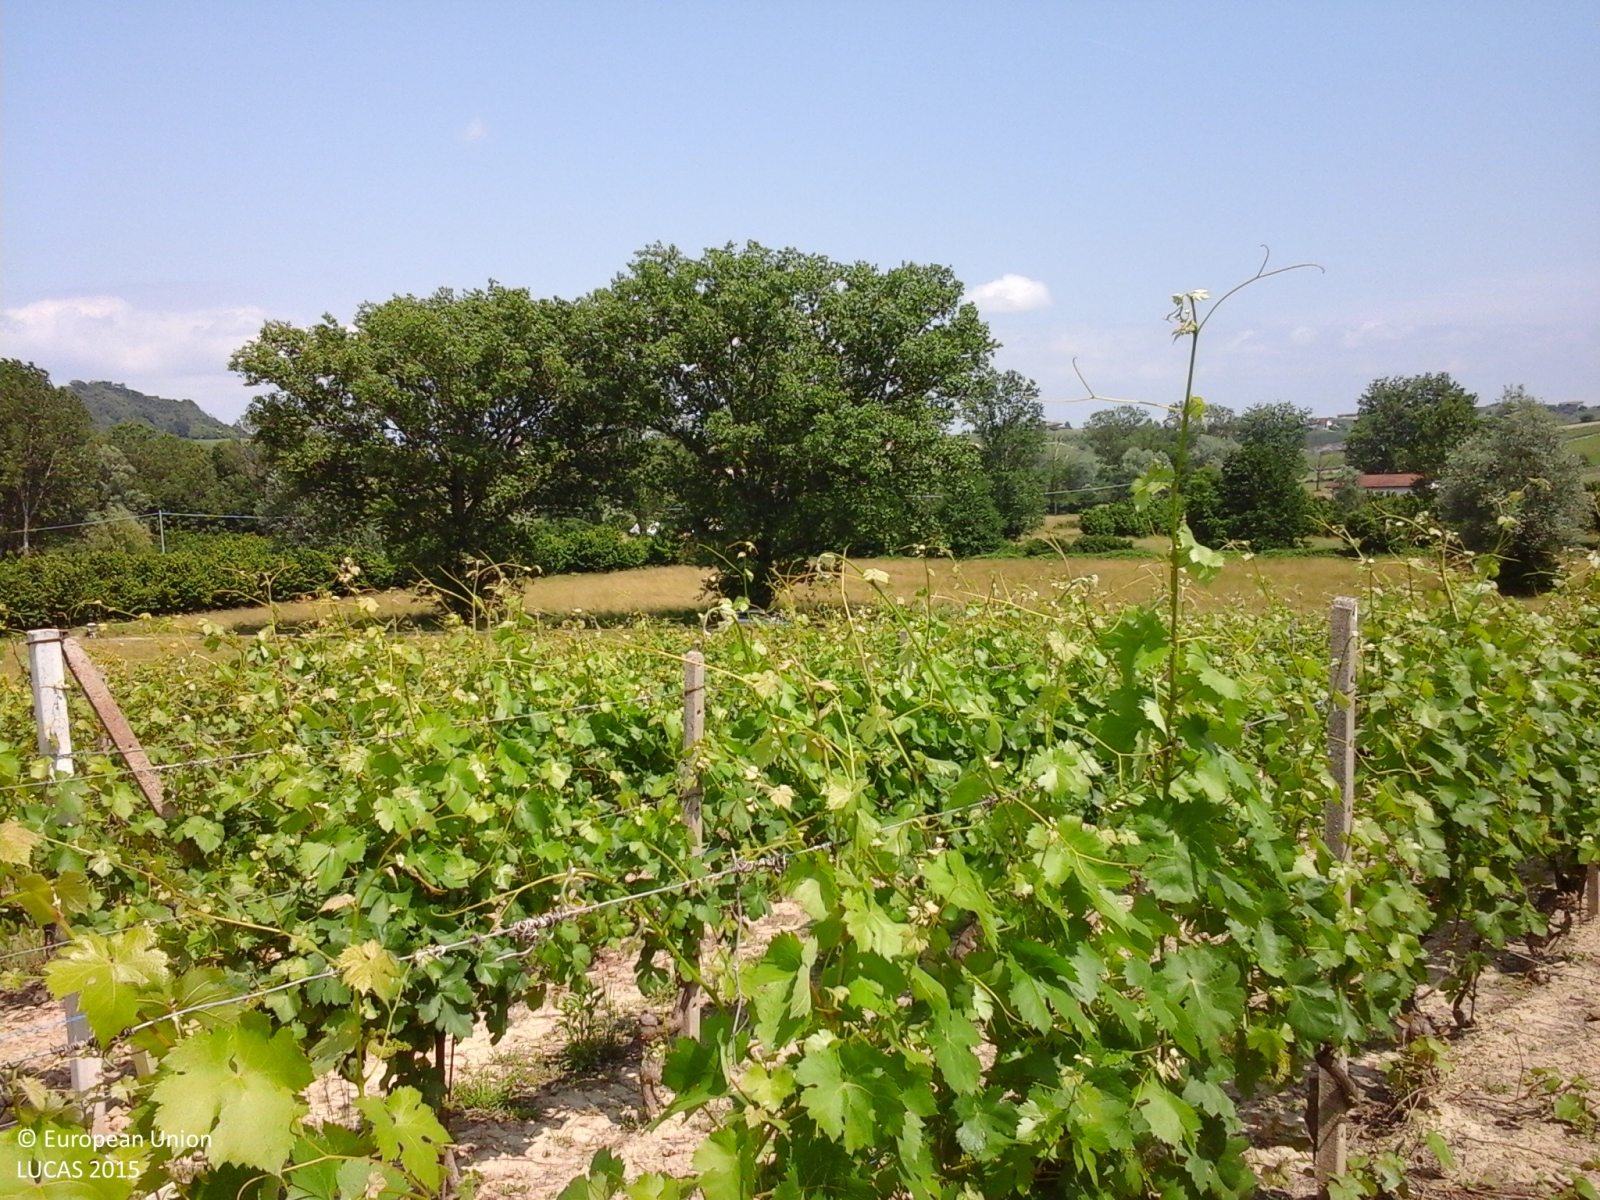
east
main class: Cropland
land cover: Vineyards
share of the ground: 50 - 75 %
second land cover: Grassland without tree/shrub cover
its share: 25 - 50 %
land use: Agriculture (excluding fallow land and kitchen gardens)
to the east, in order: Vineyards; Grassland without tree/shrub cover; Tracks; Grassland without tree/shrub cover; Abandoned hedges; Tracks; Ditches and canals; Abandoned hedges; Grassland without tree/shrub cover; Shrubland with sparse tree cover; Grassland without tree/shrub cover; Paved roads, cycling and walking lanes; Grassland without tree/shrub cover; Electric lines; Grassland without tree/shrub cover; Tracks
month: May
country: IT
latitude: 44.7682
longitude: 8.2220
